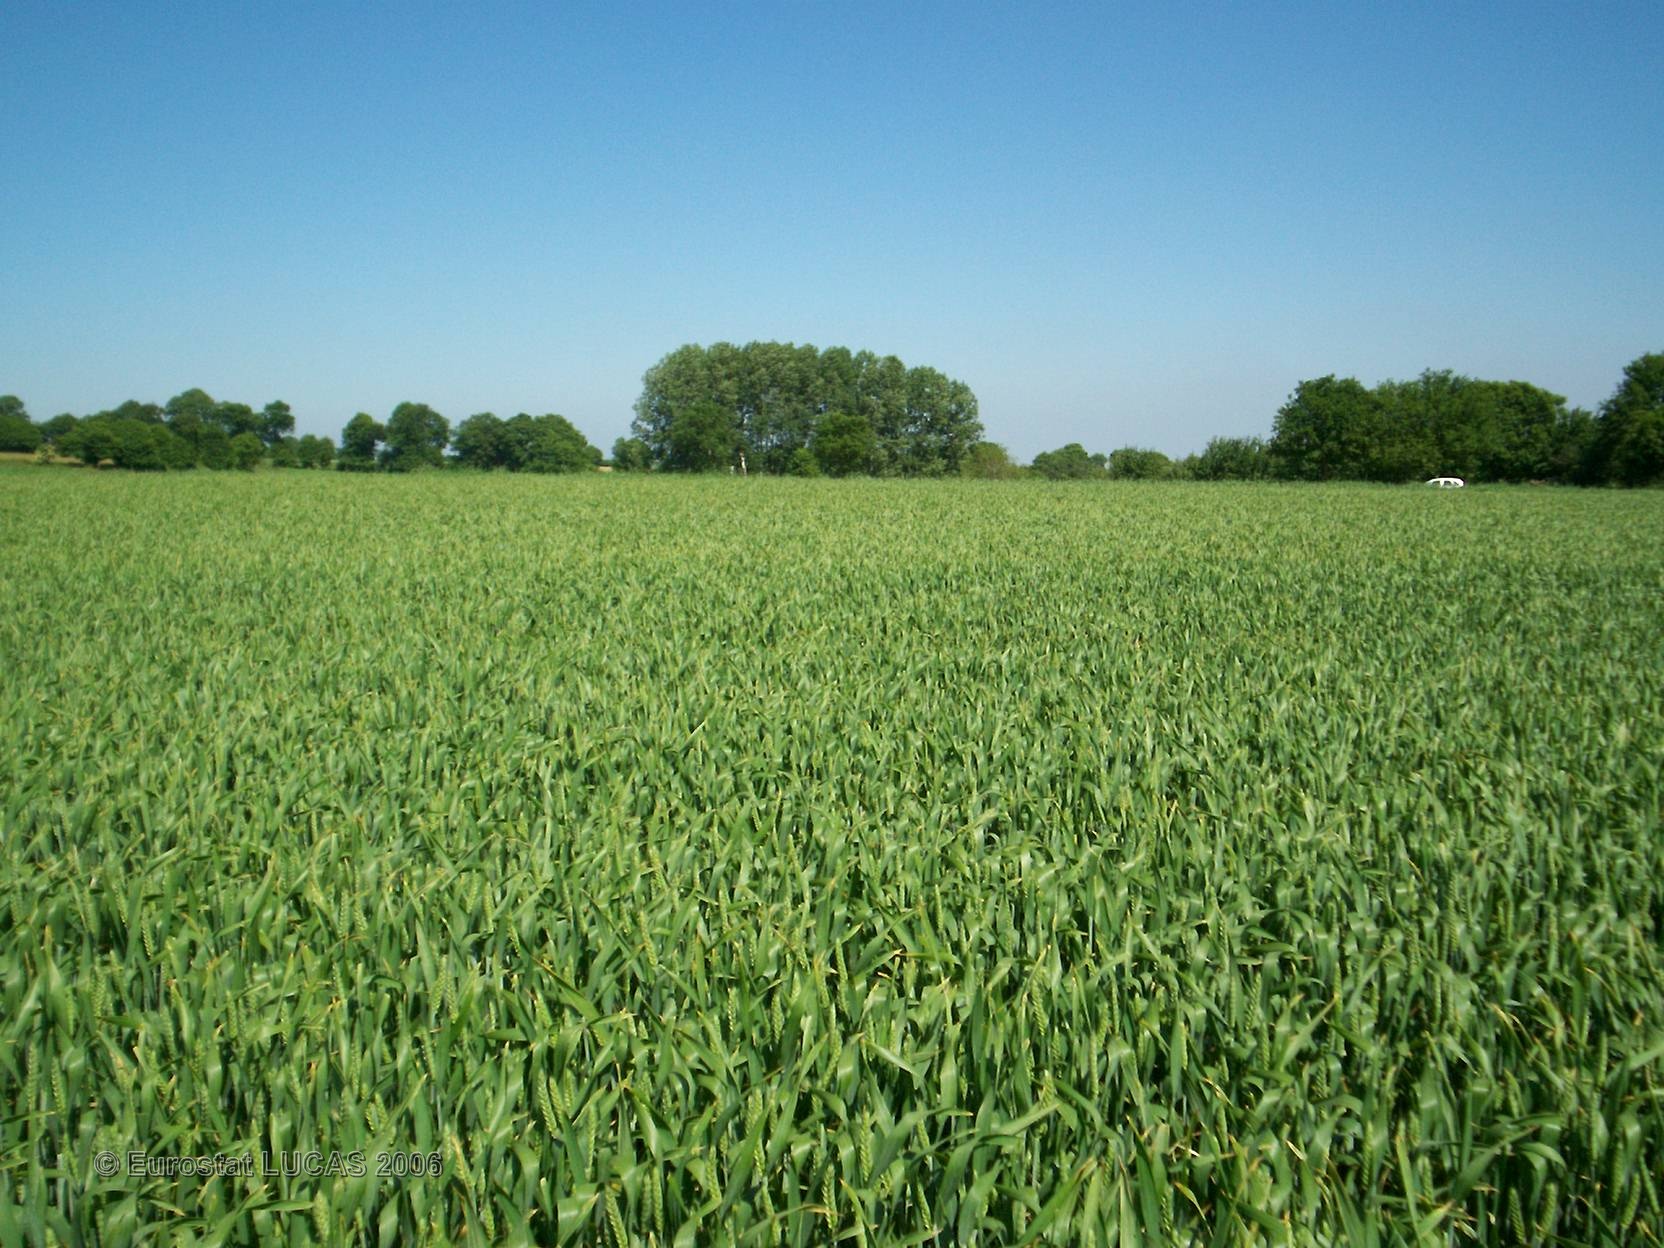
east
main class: Cropland
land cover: Common wheat
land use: Agriculture (excluding fallow land and kitchen gardens)
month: June
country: FR
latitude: 48.4180
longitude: -1.6830
